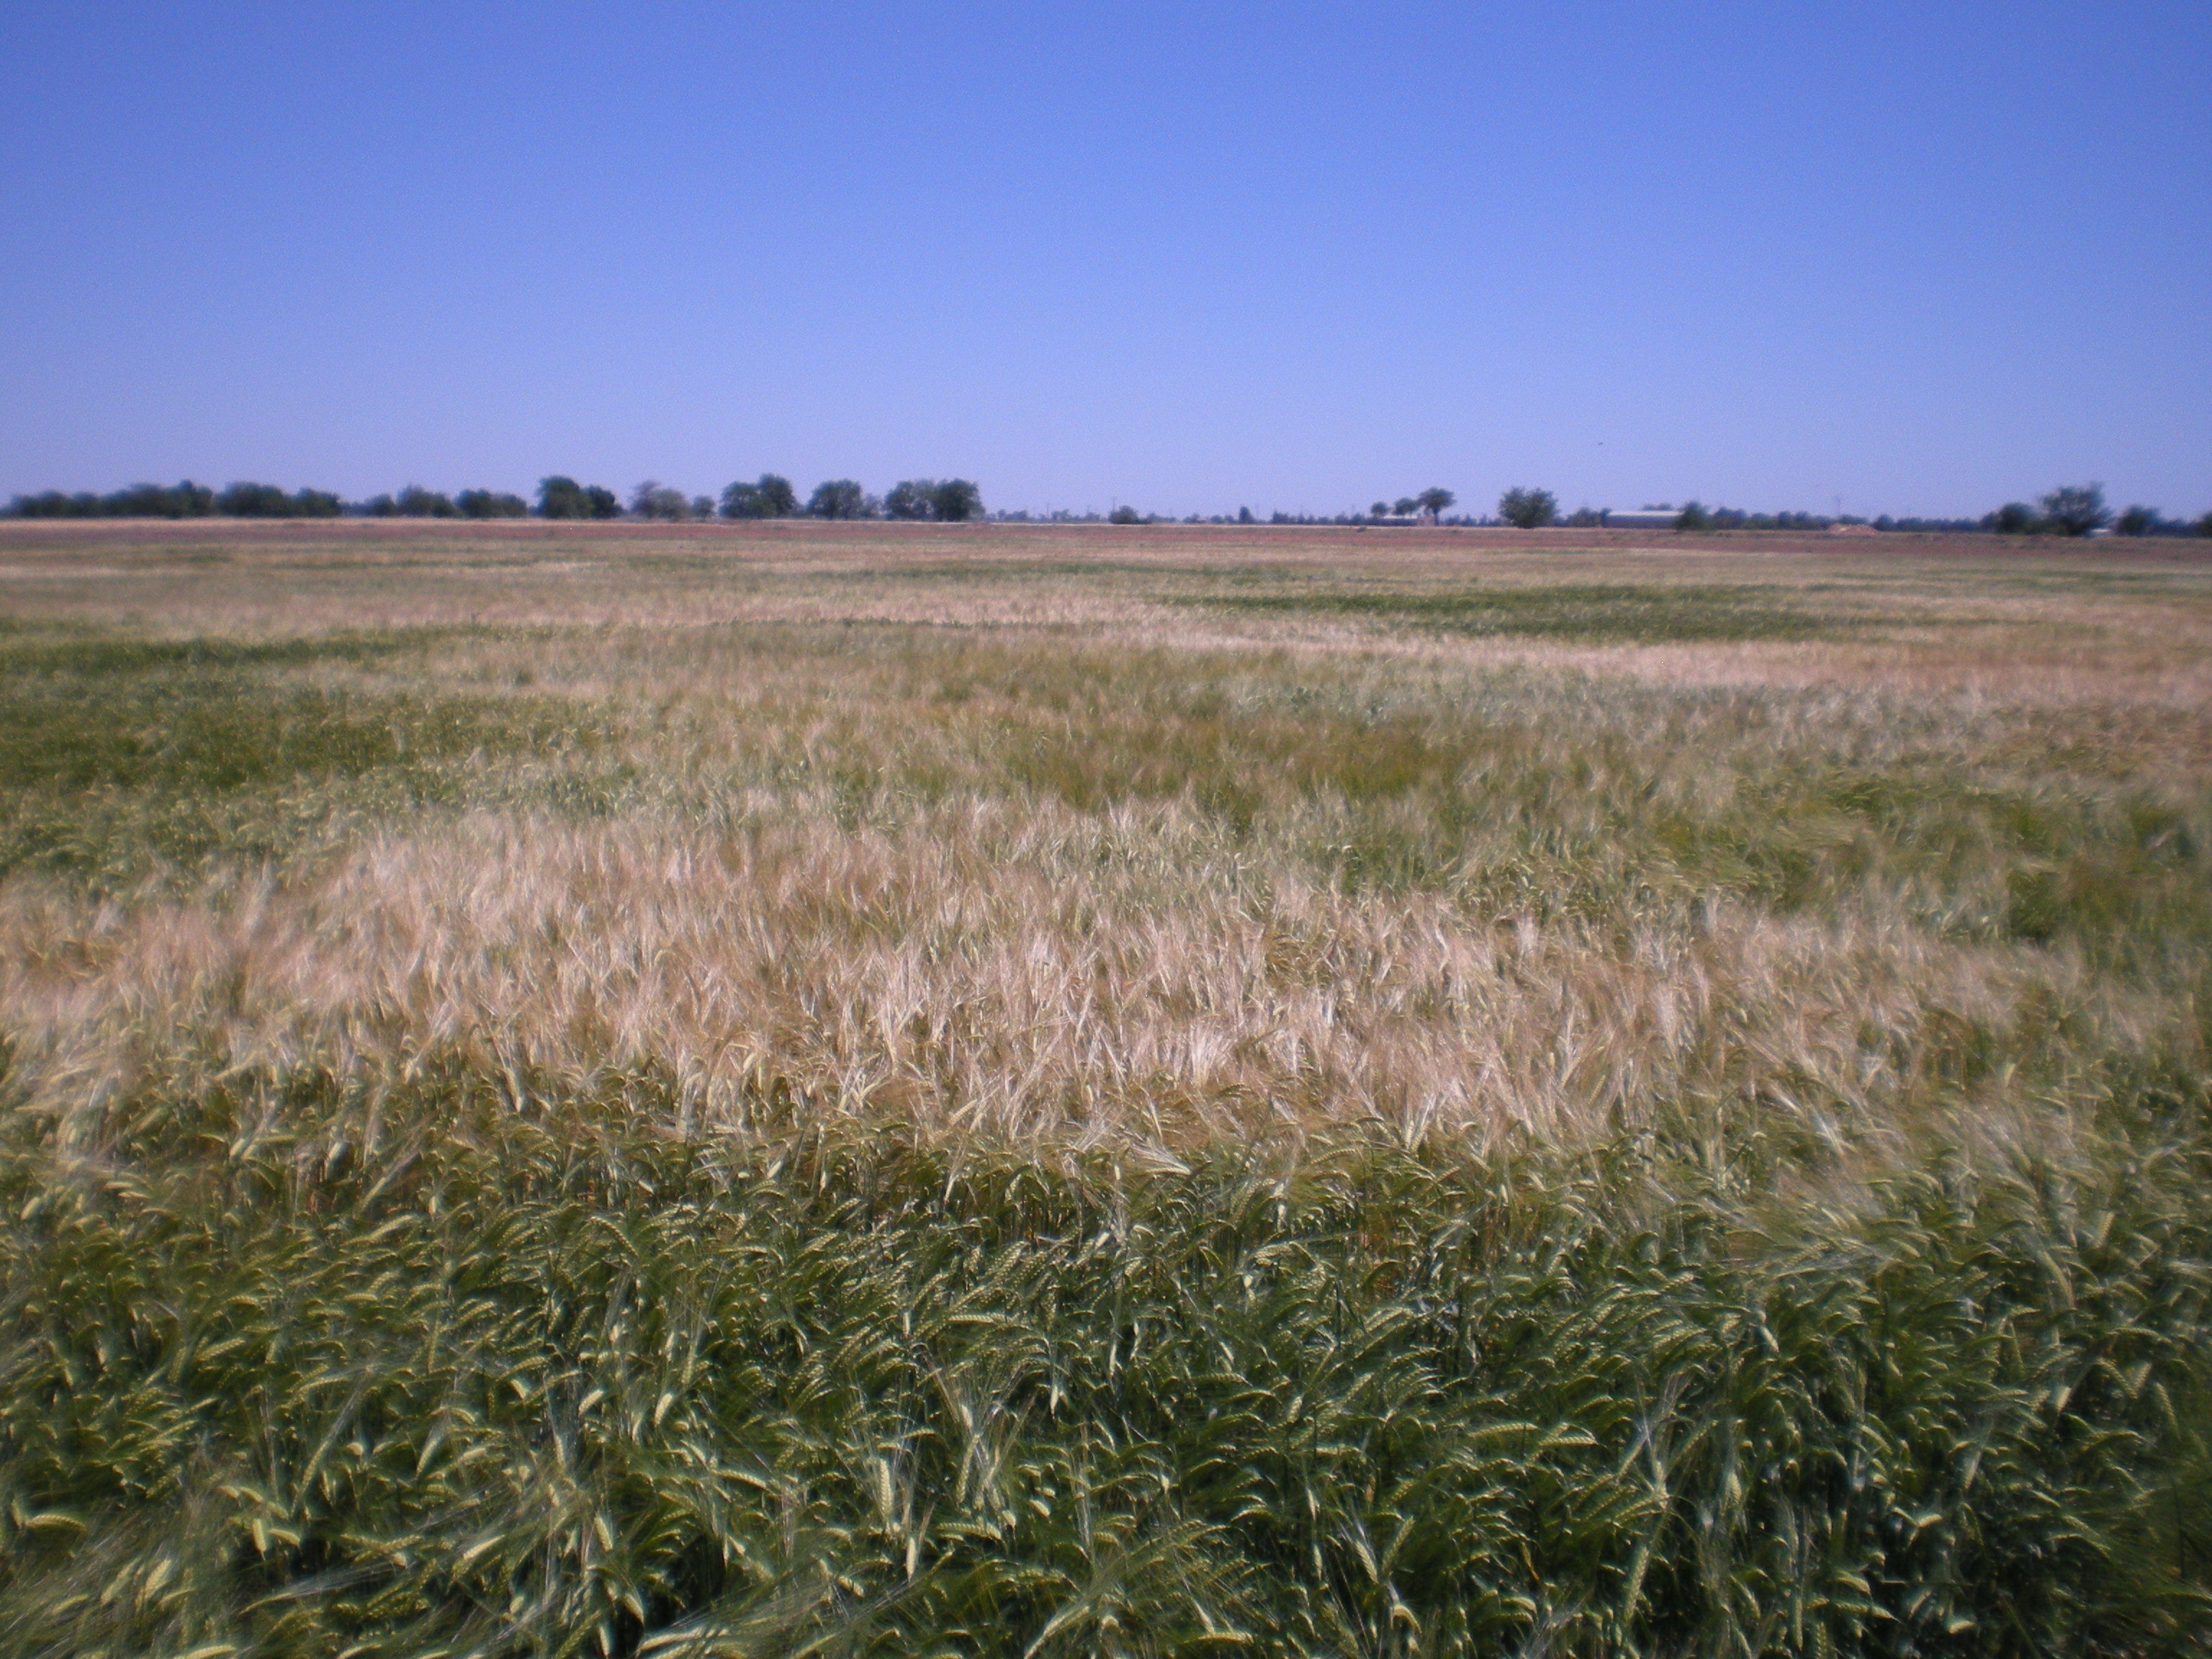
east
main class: Cropland
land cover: Barley
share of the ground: > 75 %
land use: Agriculture (excluding fallow land and kitchen gardens)
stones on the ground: 10 - 25 %
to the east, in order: Barley; Grass margins; Tracks; Grass margins; Other bare soil
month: May
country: ES
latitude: 39.1437
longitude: -3.1225
